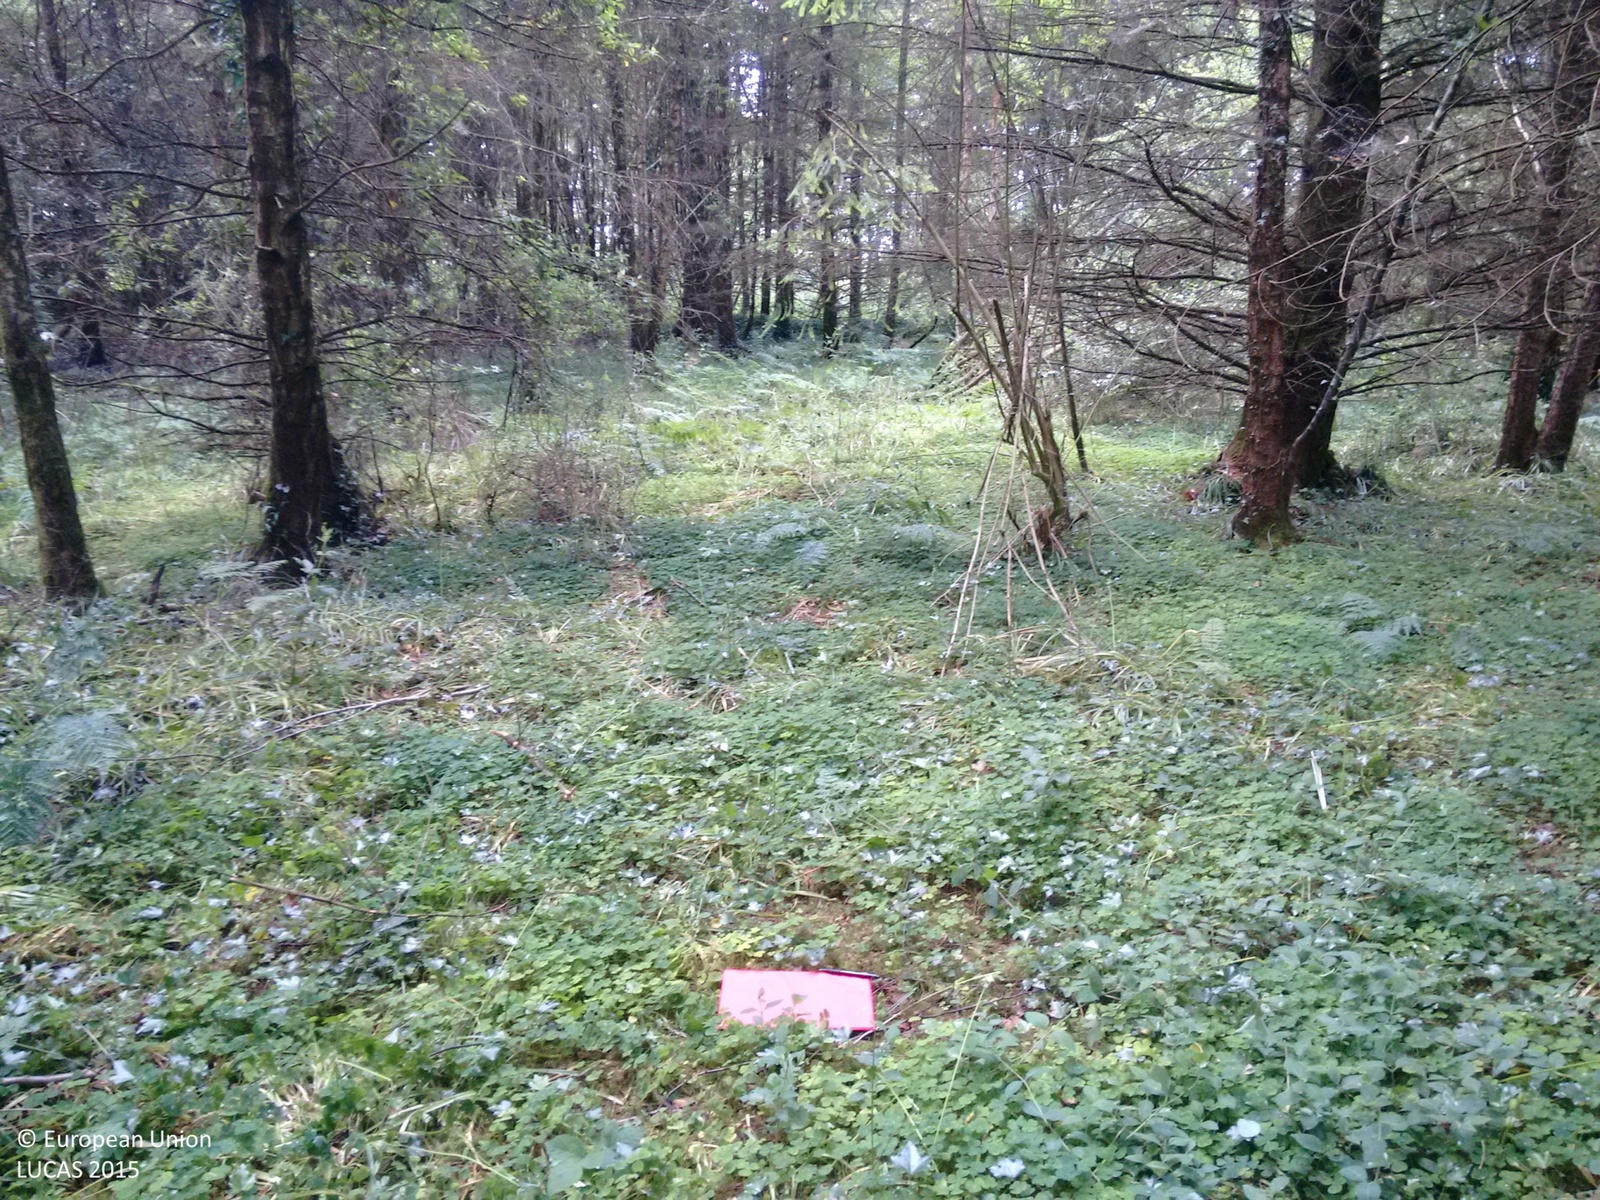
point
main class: Woodland
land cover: Spruce dominated mixed woodland
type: boreal forest
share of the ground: > 75 %
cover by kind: coniferous forest trees 60 %, broadleaved forest trees 30 %, shrubs 10 %
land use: Forestry
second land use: Amenities, museums, leisure
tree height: > 5 m
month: June
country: IE
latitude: 53.4286
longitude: -7.8229
